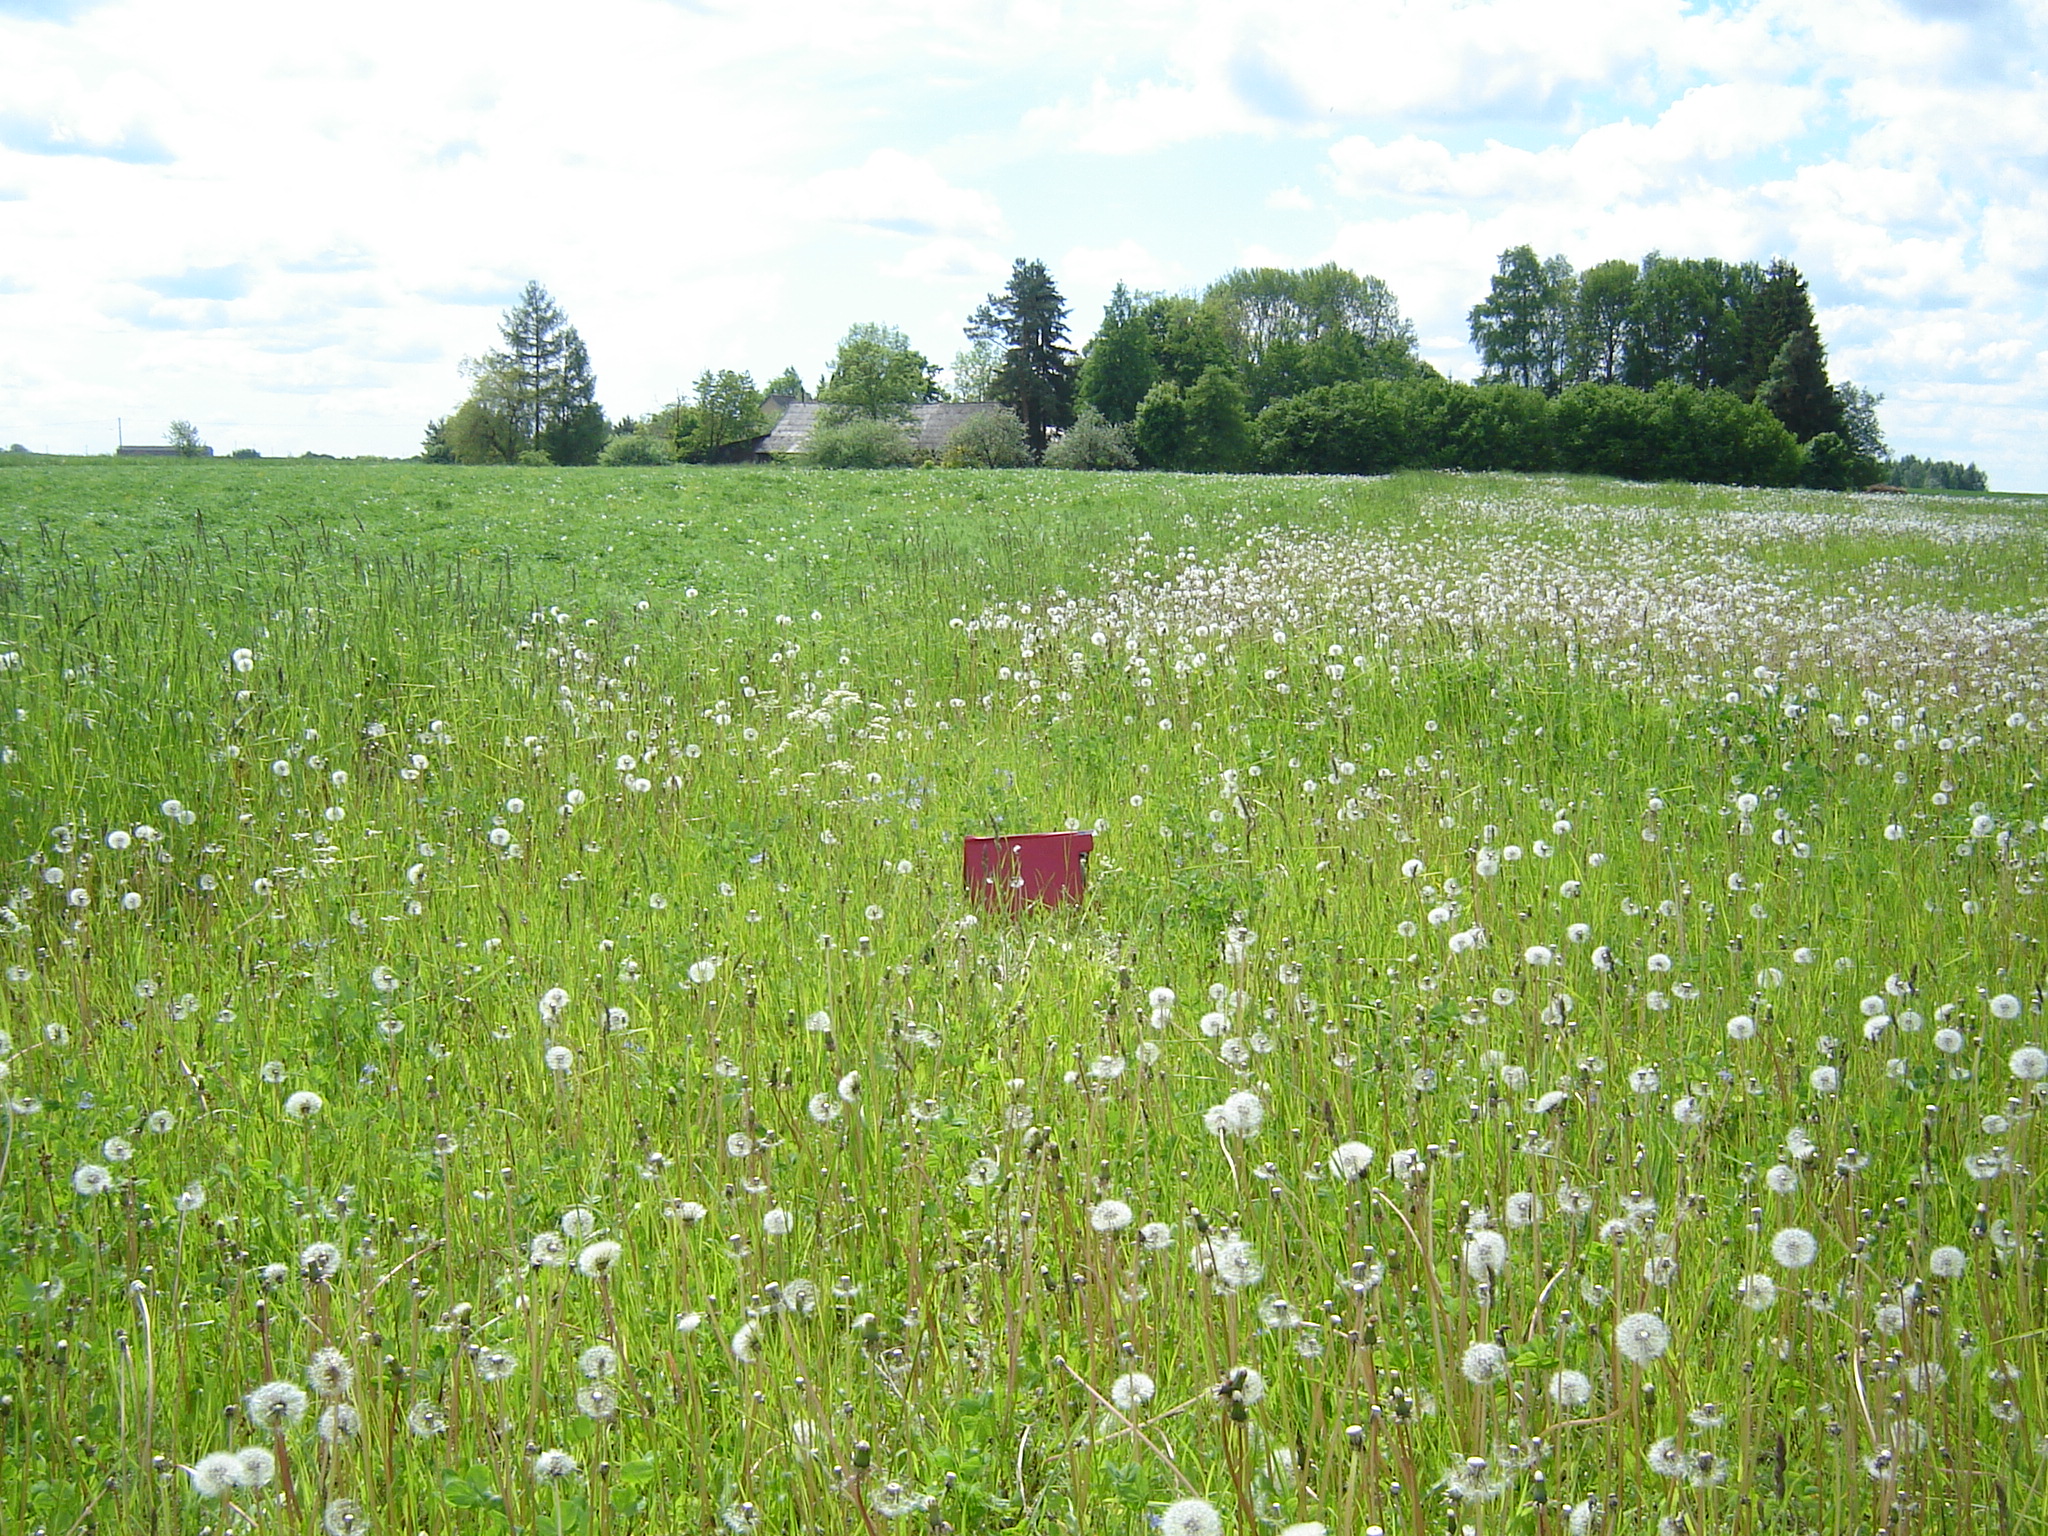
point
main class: Grassland
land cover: Grassland without tree/shrub cover
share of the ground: > 75 %
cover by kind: herbaceous plants 100 %
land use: Agriculture (excluding fallow land and kitchen gardens)
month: May
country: LT
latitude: 55.8246
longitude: 25.2000
